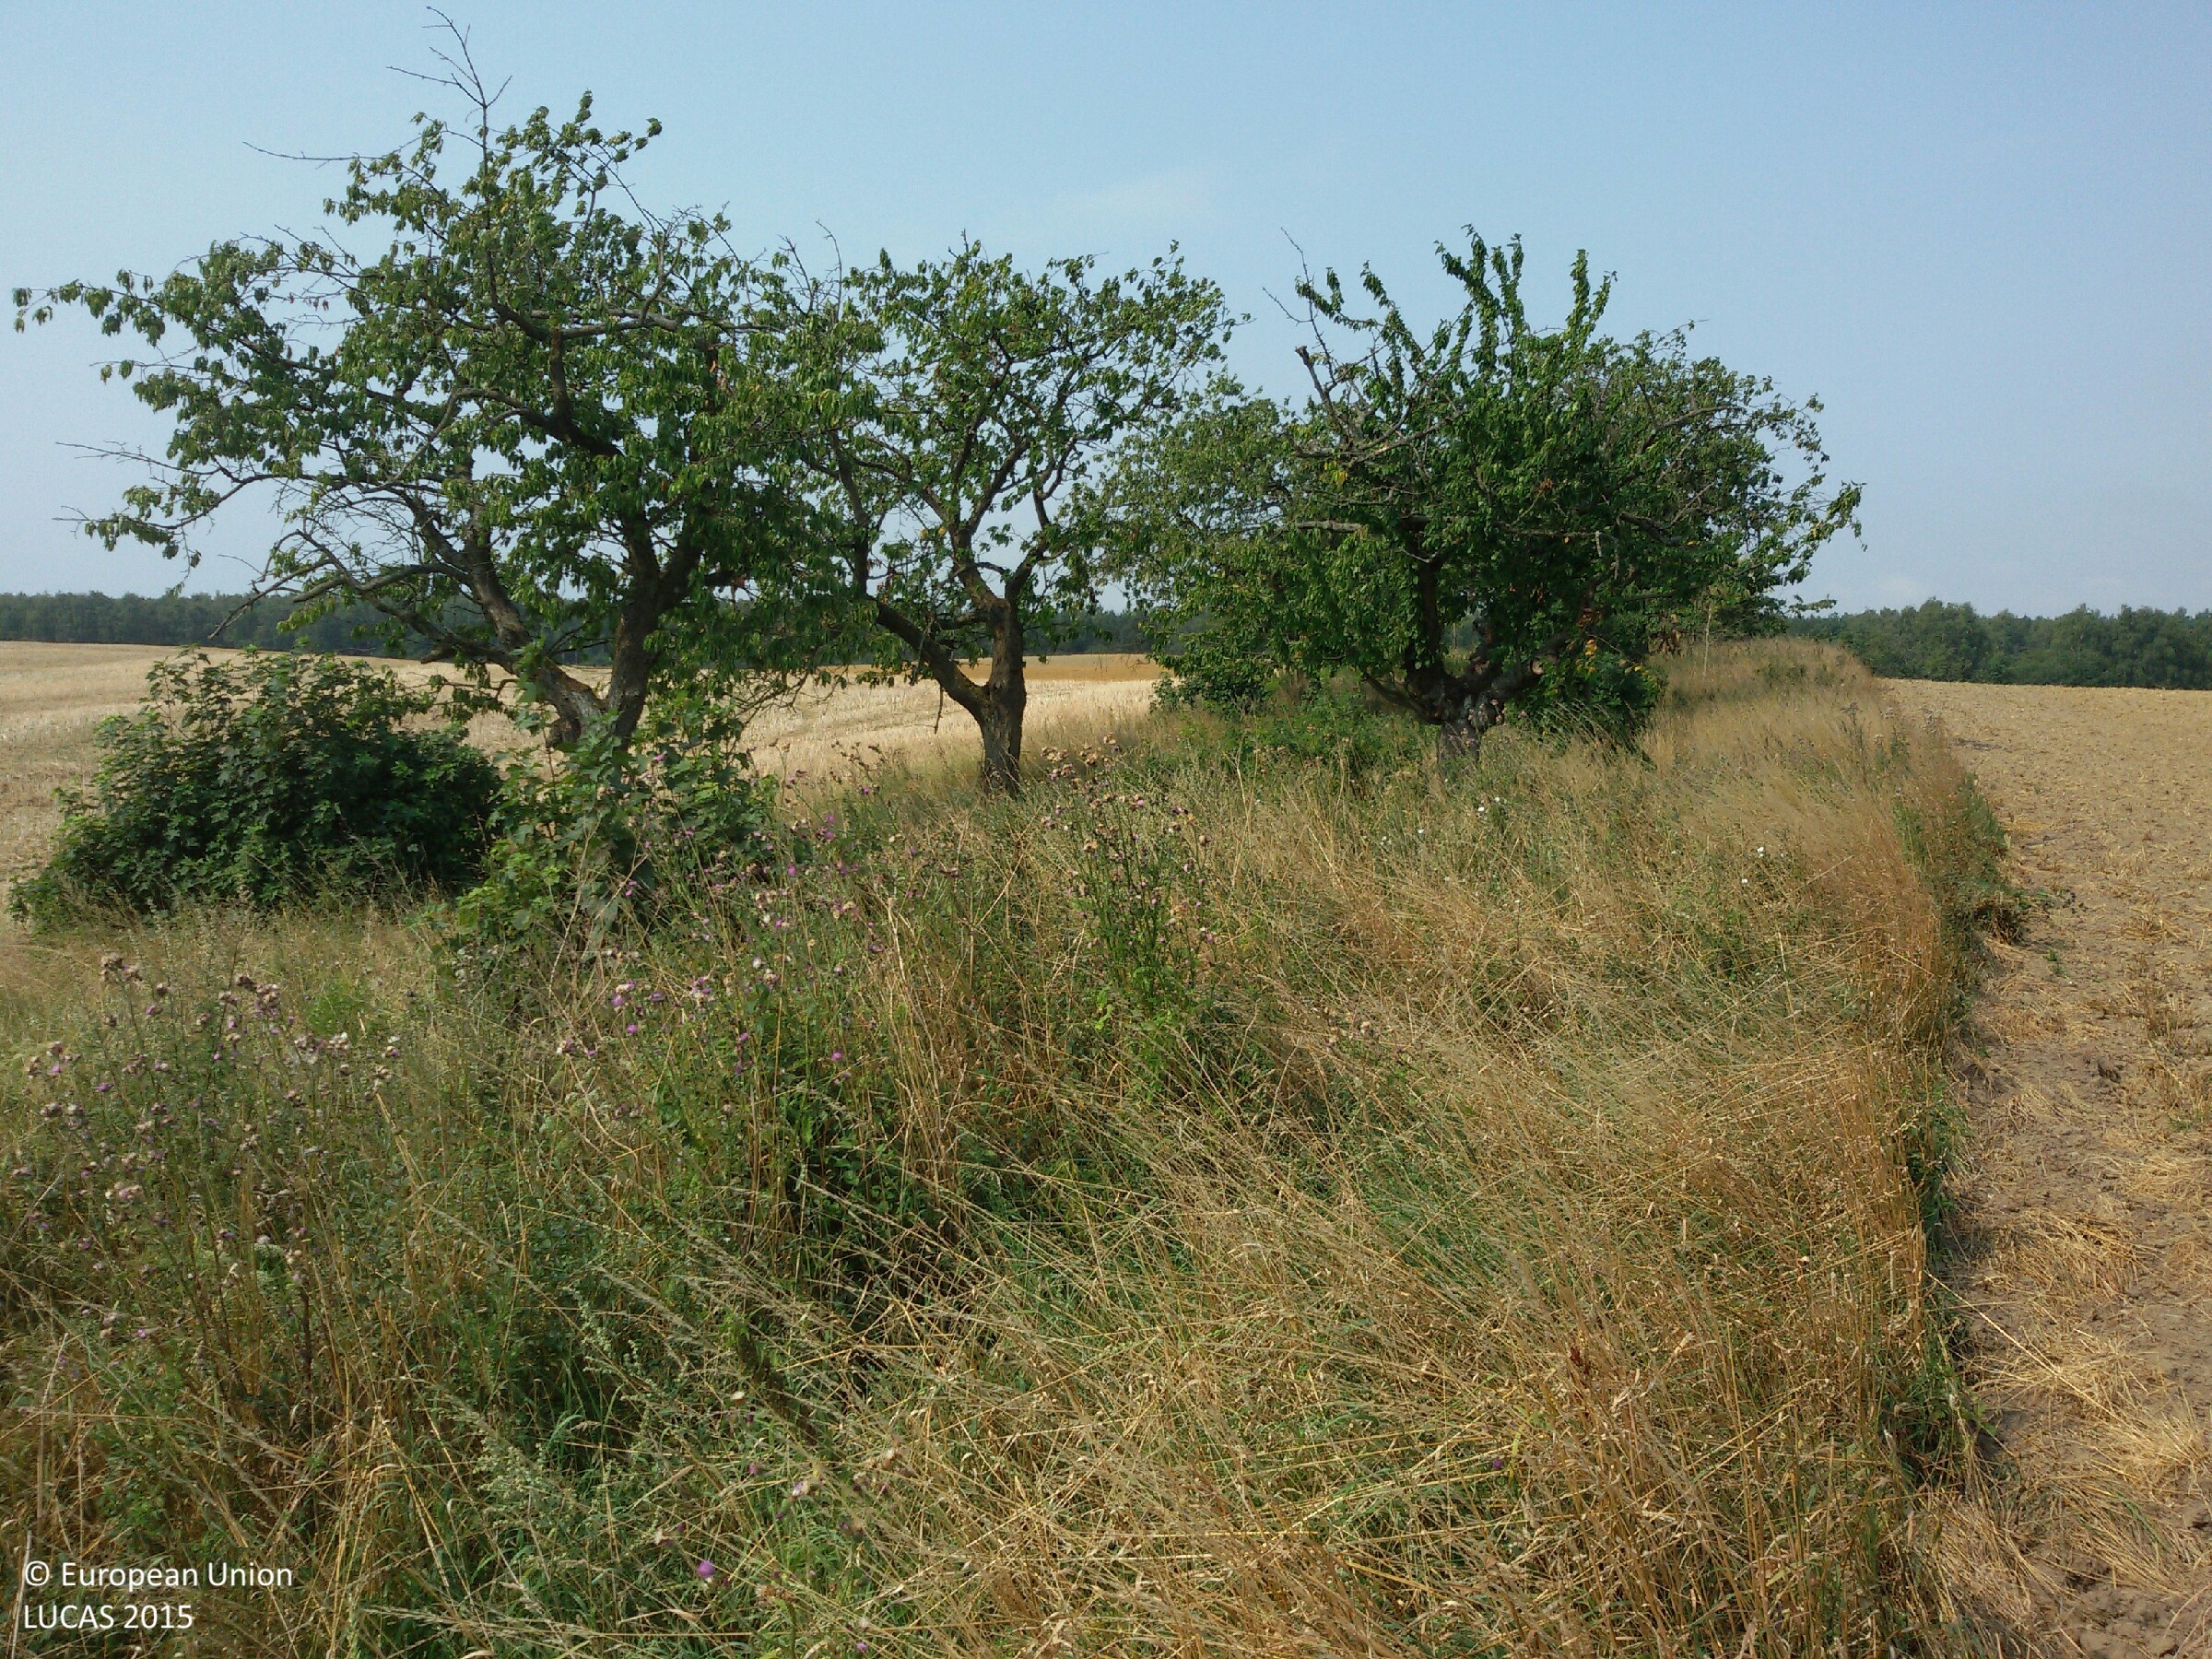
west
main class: Cropland
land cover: Common wheat
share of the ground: > 75 %
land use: Agriculture (excluding fallow land and kitchen gardens)
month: August
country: PL
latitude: 52.8704
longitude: 14.4433
